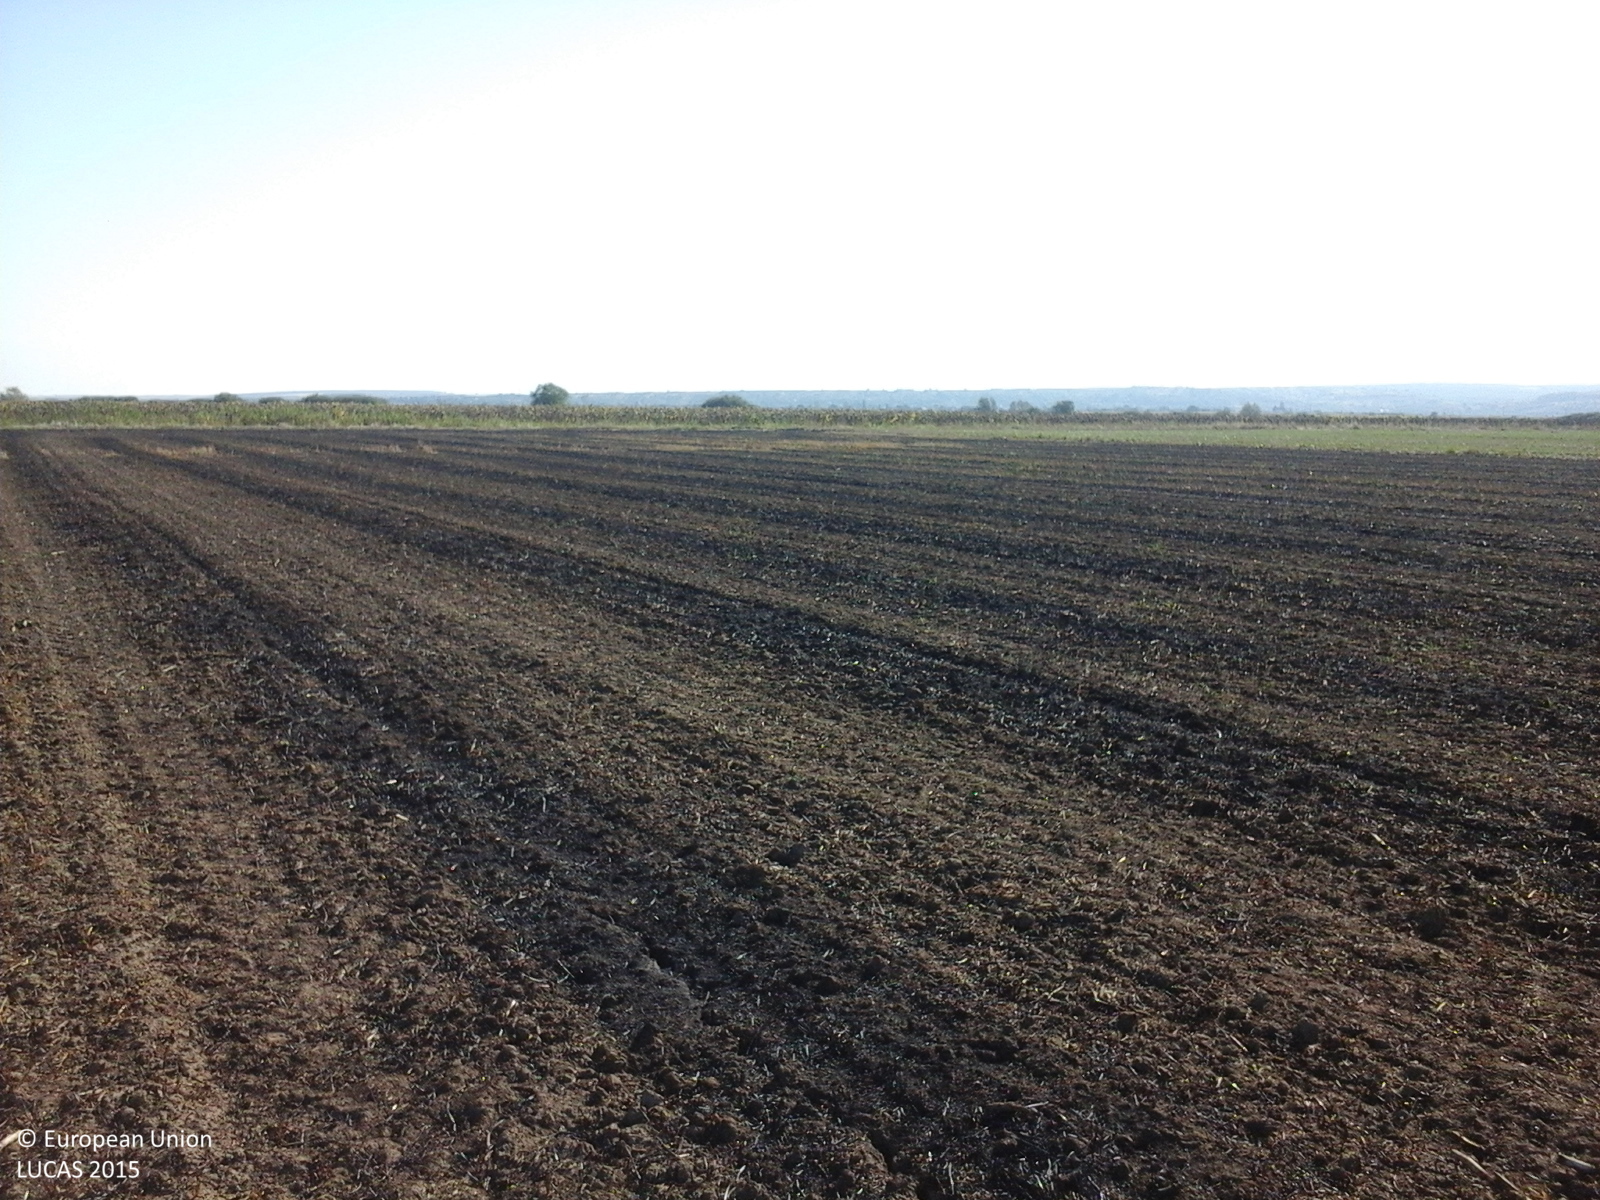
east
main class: Cropland
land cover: Common wheat
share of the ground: < 10 %
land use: Agriculture (excluding fallow land and kitchen gardens)
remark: Burnt area
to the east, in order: Common wheat; Grass margins; Tracks; Grass margins; Rape and turnip rape; Grass margins; Ditches and canals; Grass margins; Common wheat
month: September
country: RO
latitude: 47.5461
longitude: 22.8041
